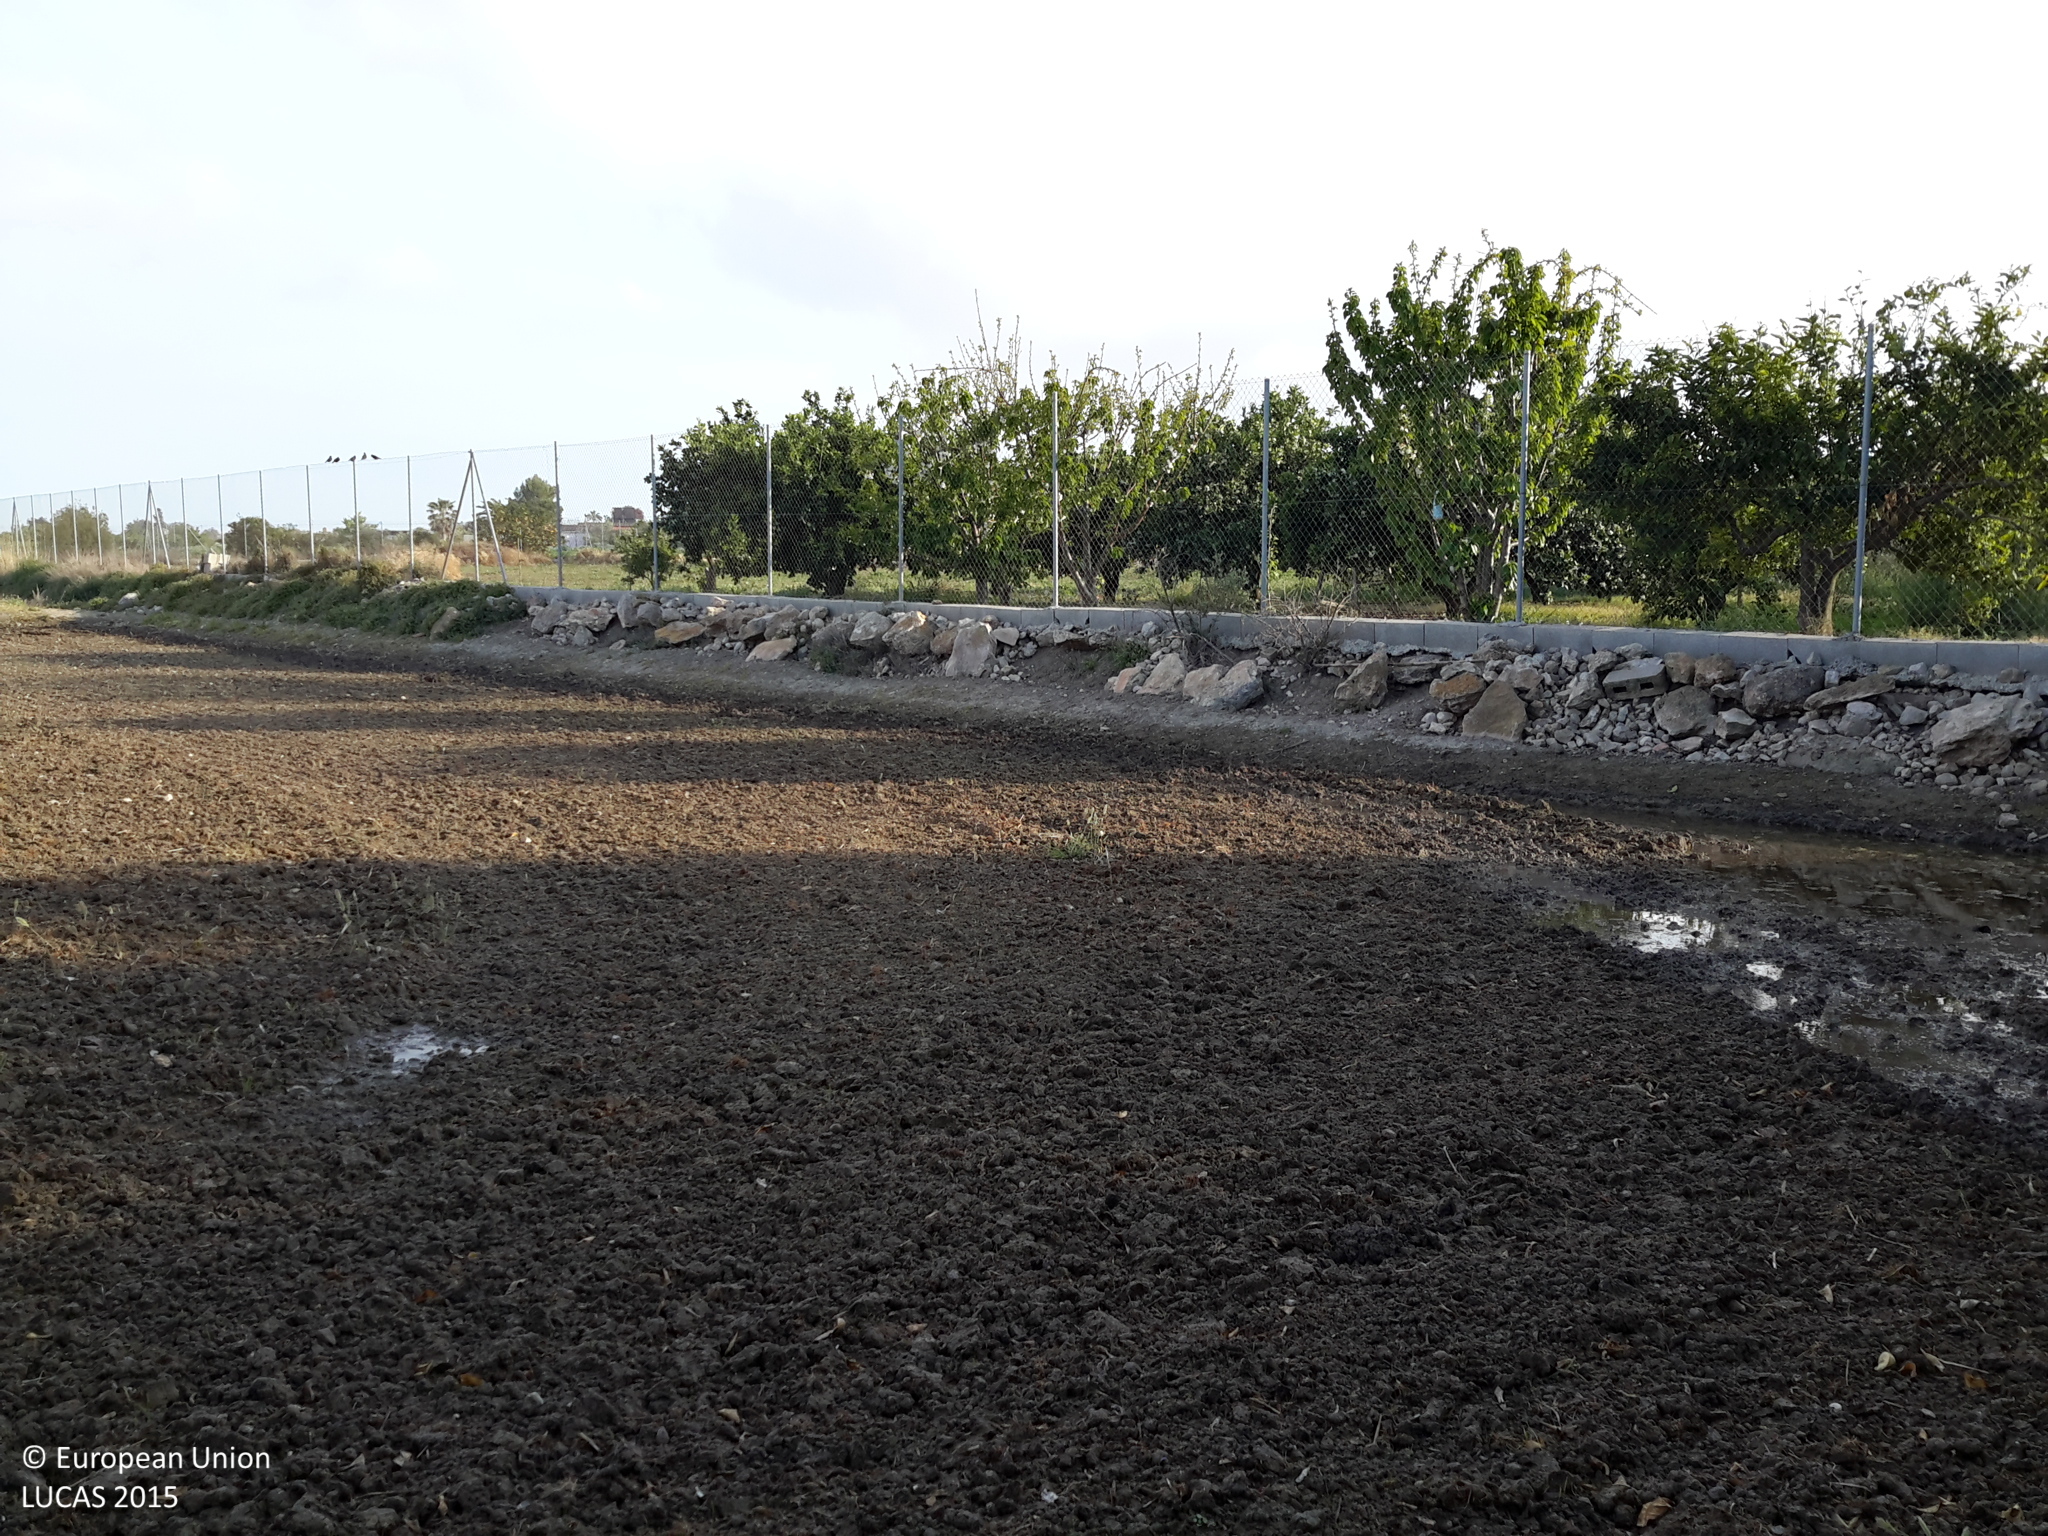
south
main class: Cropland
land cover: Oranges
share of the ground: 25 - 50 %
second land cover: Spontaneously vegetated surfaces
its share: 50 - 75 %
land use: Agriculture (excluding fallow land and kitchen gardens)
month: April
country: ES
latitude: 40.6517
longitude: 0.5935
